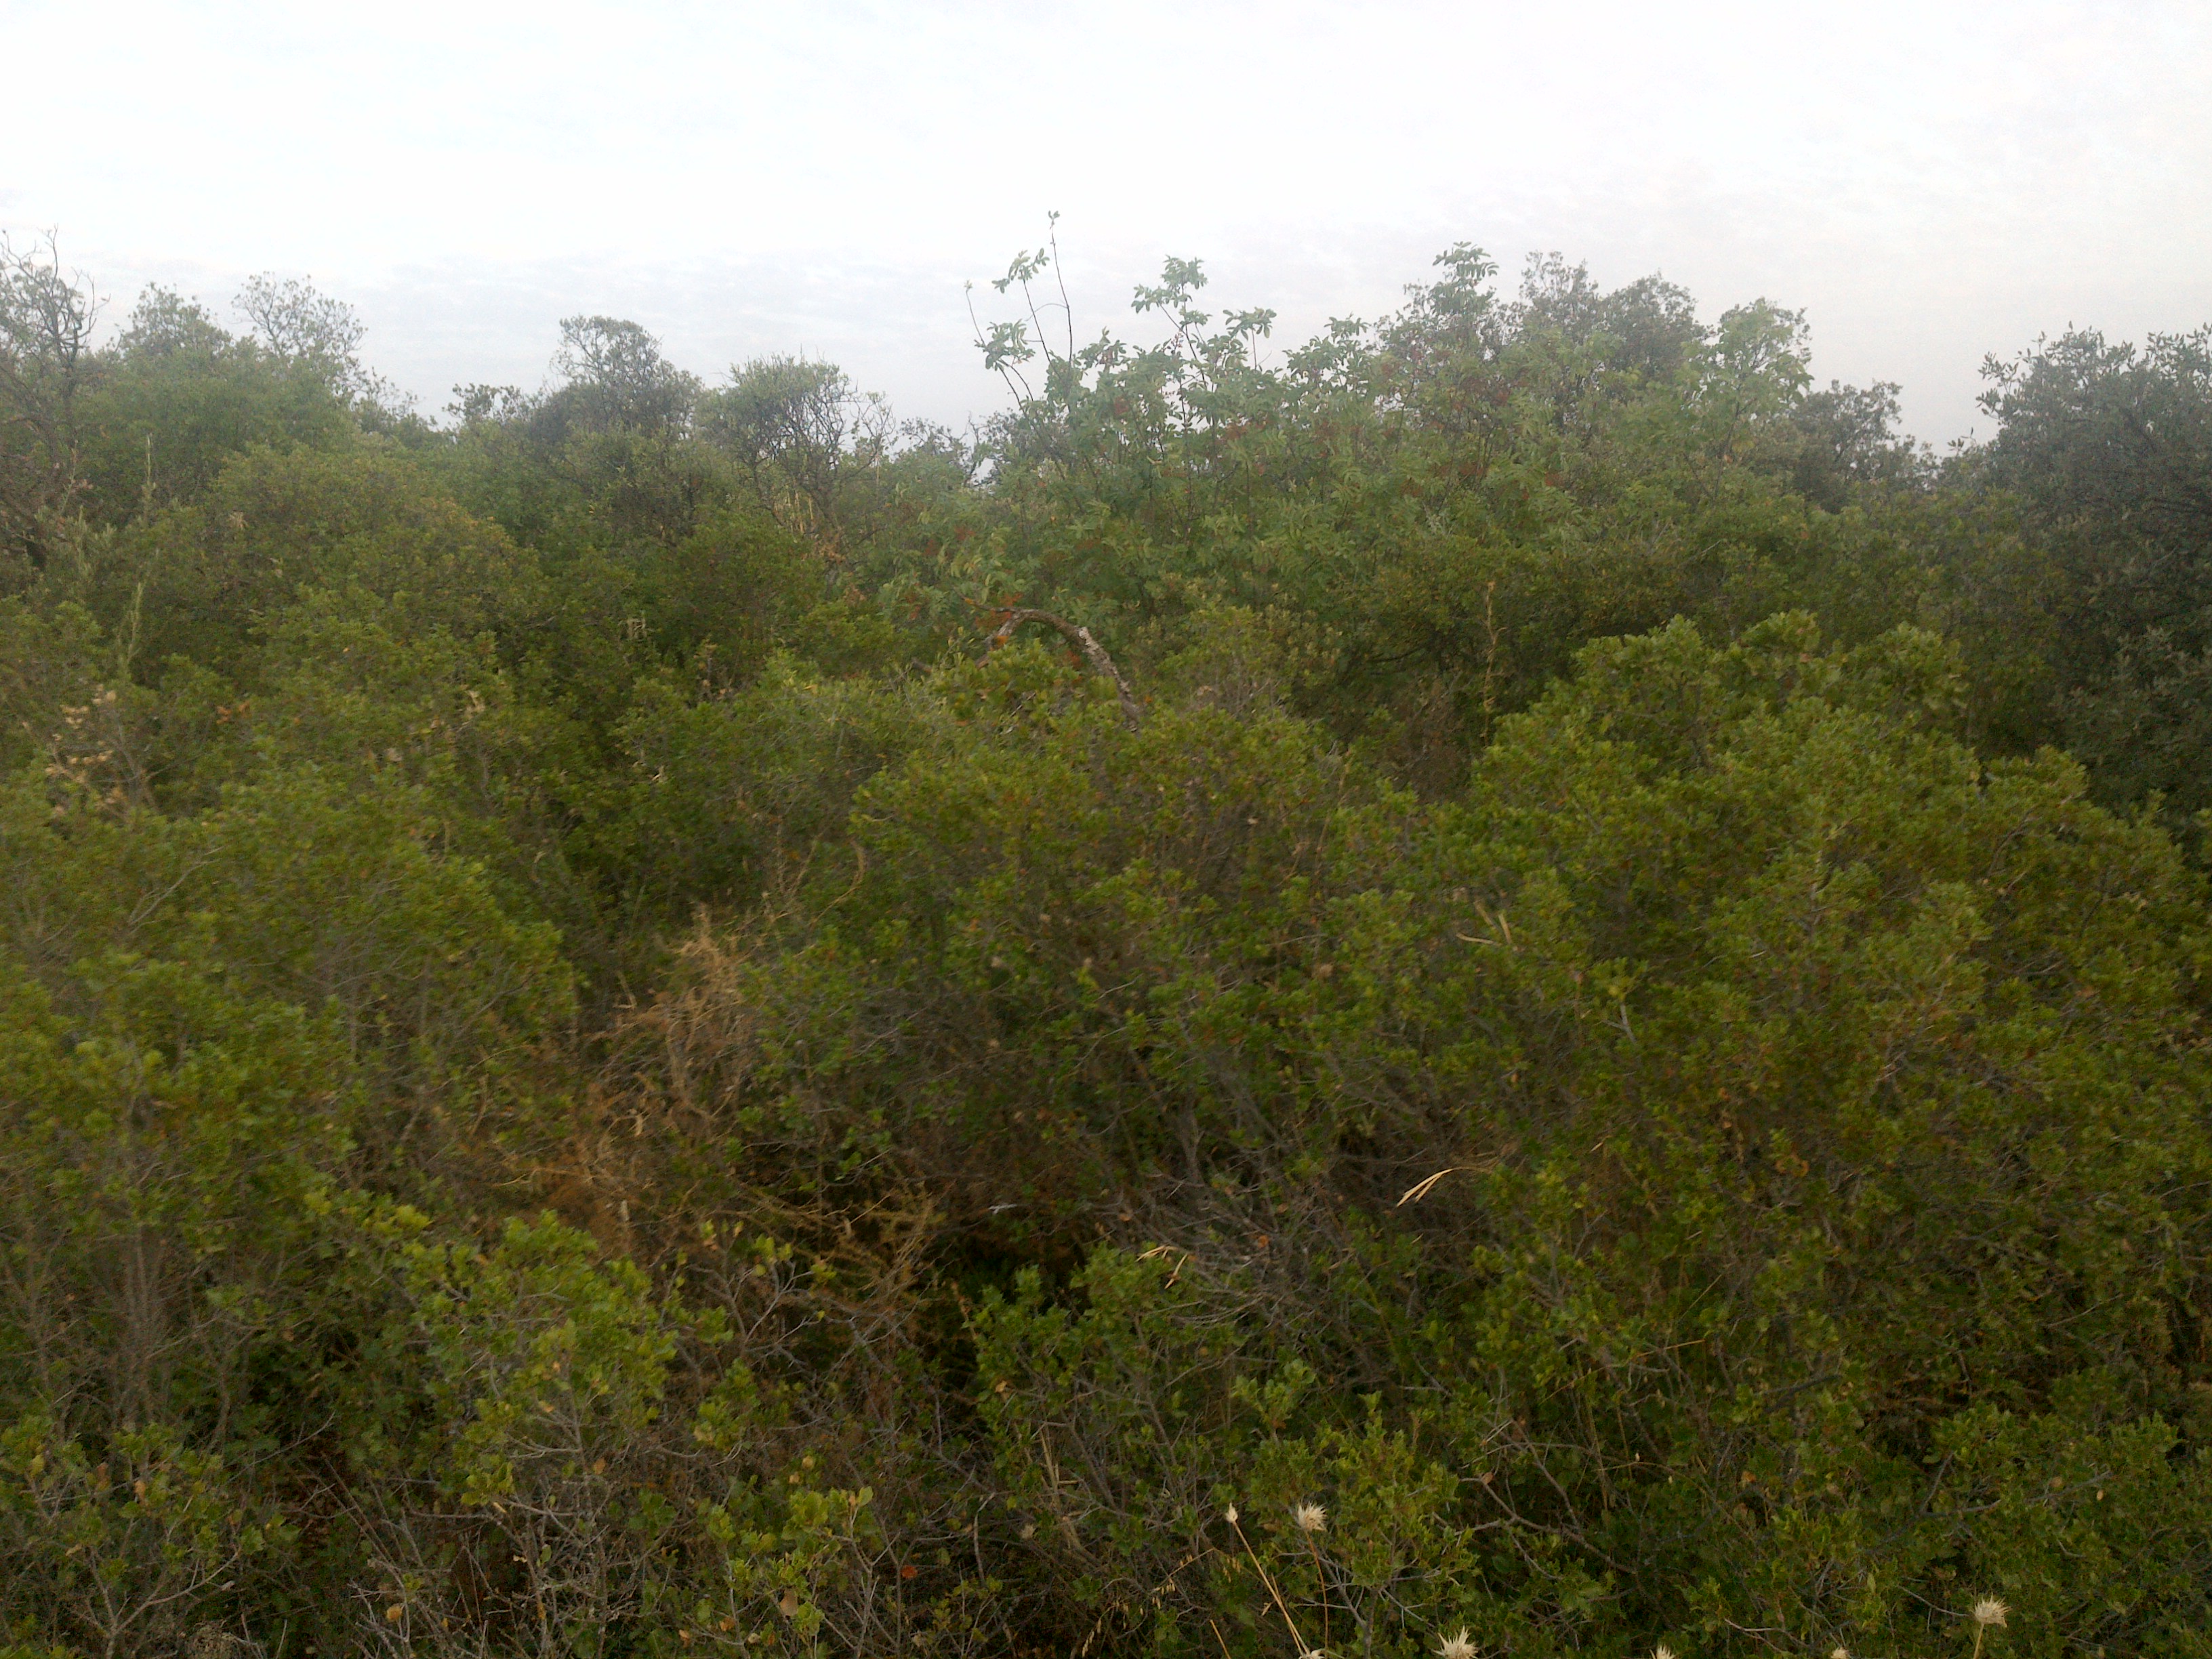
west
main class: Shrubland
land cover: Shrubland with sparse tree cover
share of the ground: 50 - 75 %
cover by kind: shrubs 50 %, unconsolidated bare surface 30 %, herbaceous plants 15 %, broadleaved forest trees 5 %
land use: Semi-natural and natural areas not in use
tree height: < 5 m
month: July
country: ES
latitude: 37.4875
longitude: -4.4230
